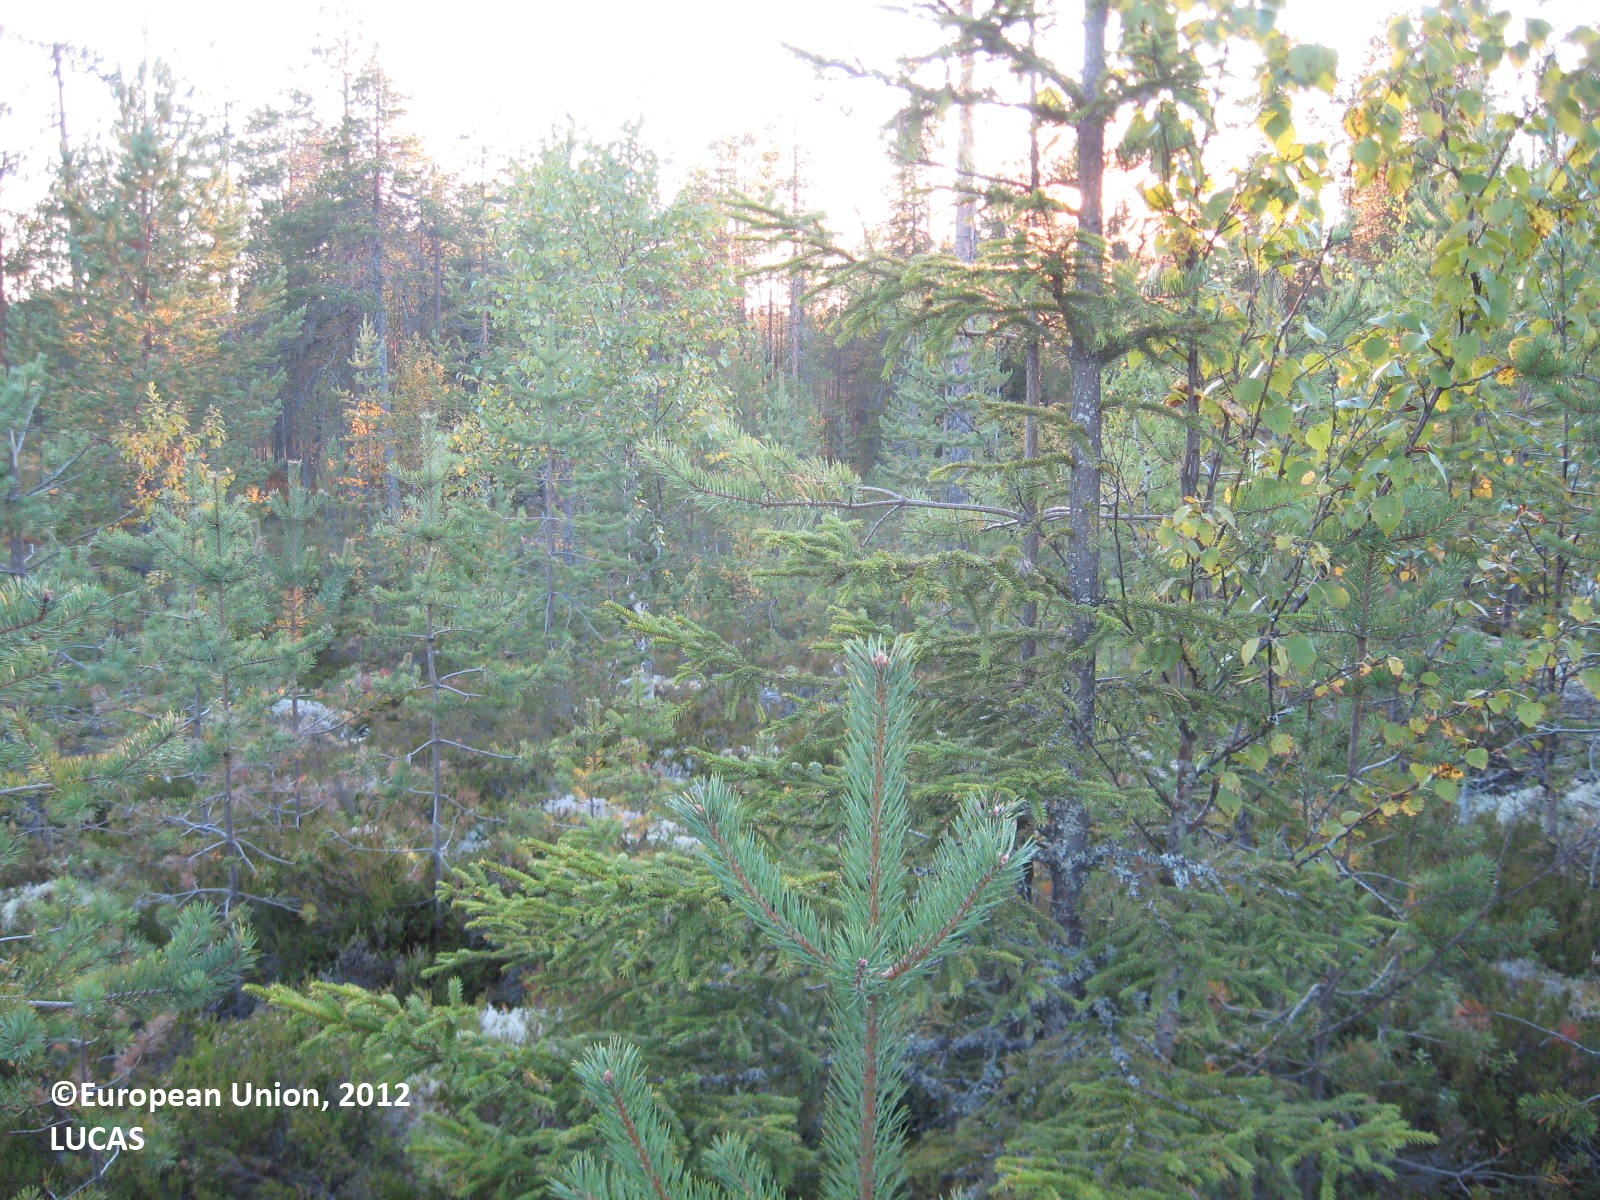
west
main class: Woodland
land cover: Pine dominated coniferous woodland
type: boreal forest
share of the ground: 50 - 75 %
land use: Forestry
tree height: < 5 m
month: August
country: FI
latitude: 63.8445
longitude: 29.7737
